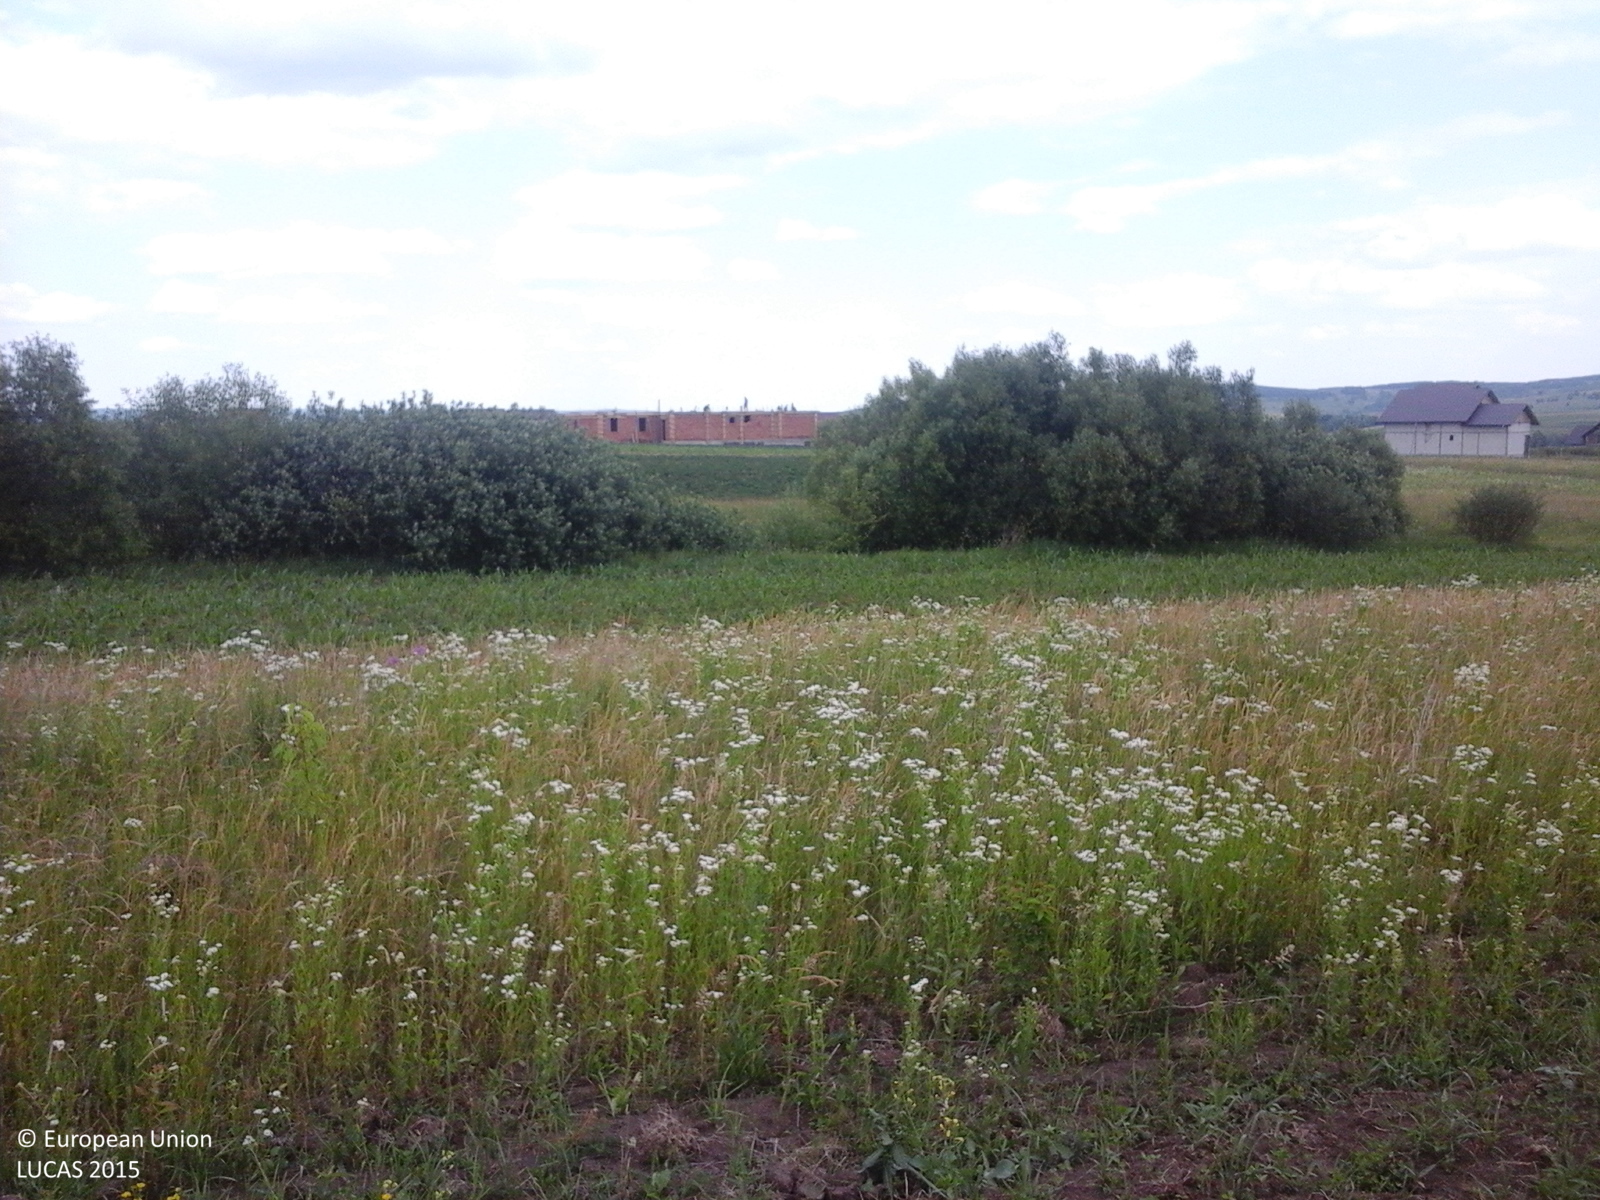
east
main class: Grassland
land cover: Spontaneously vegetated surfaces
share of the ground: 10 - 25 %
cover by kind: herbaceous plants 100 %
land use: Fallow land
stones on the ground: < 10 %
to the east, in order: Spontaneously vegetated surfaces; Grassland without tree/shrub cover; Maize; Ditches and canals; Lines of trees; Grassland without tree/shrub cover; Potatoes; Lucerne; Maize; Potatoes; Artificial constructions in urban areas; Grassland without tree/shrub cover; Ditches and canals; Paved roads, cycling and walking lanes; Ditches and canals; Grassland without tree/shrub cover
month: June
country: RO
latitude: 47.7476
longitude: 25.9614
